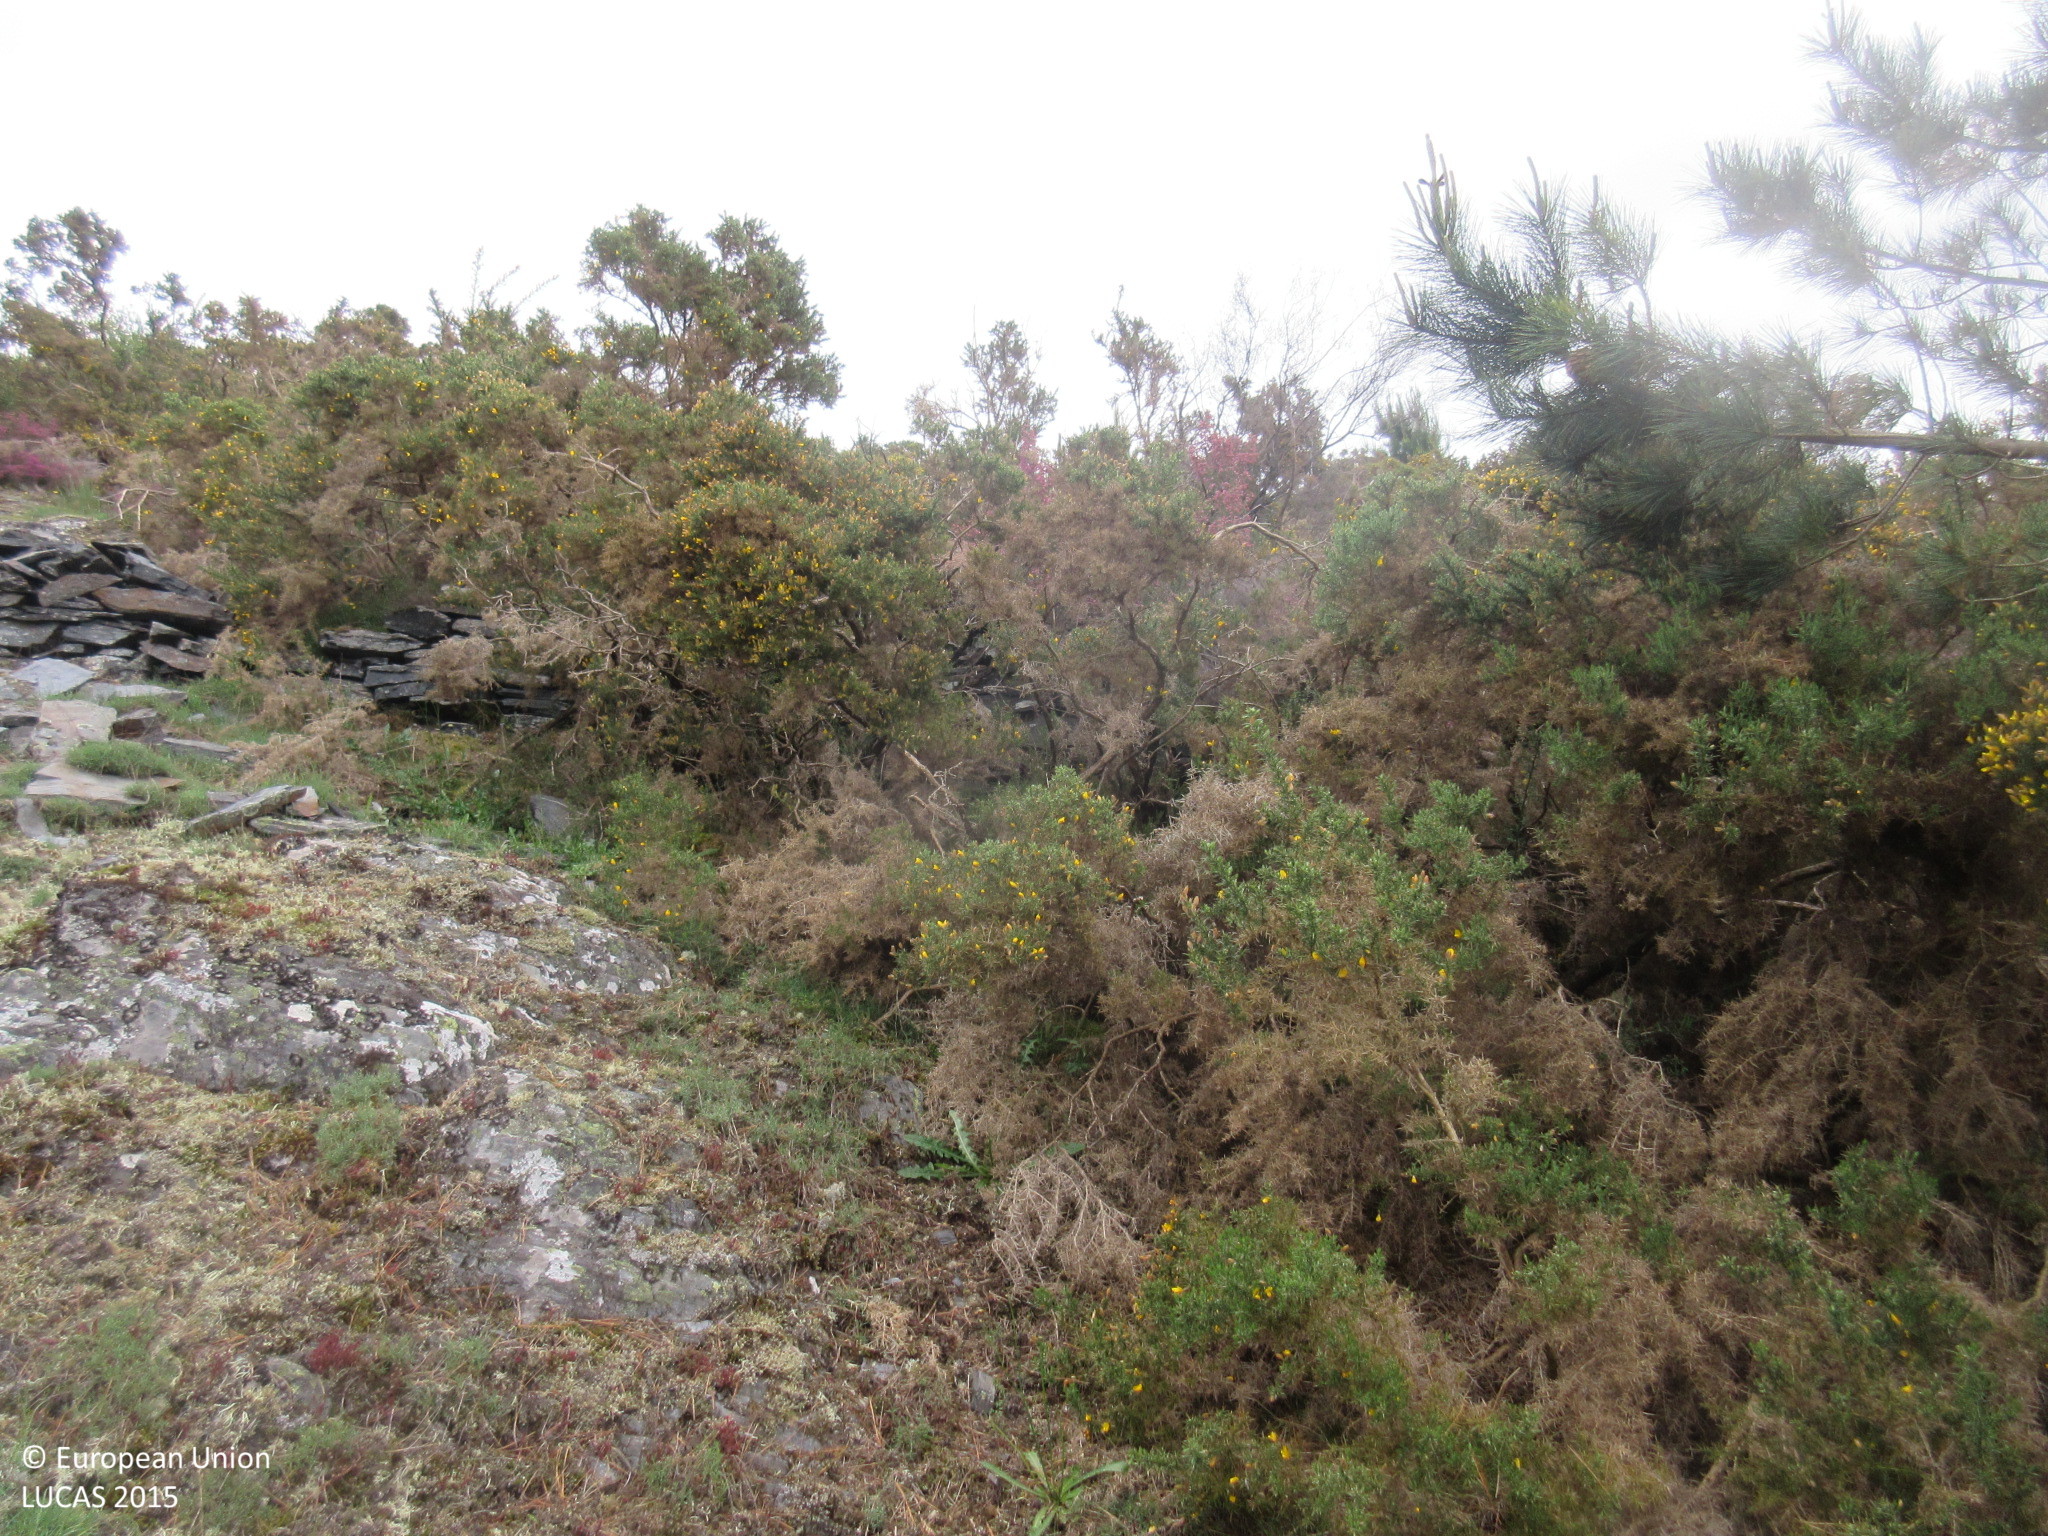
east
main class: Woodland
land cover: Broadleaved woodland
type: acidophilous oak and oak-birch forest
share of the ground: > 75 %
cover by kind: broadleaved forest trees 100 %
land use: Semi-natural and natural areas not in use
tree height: > 5 m
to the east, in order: Broadleaved woodland; Shrubland with sparse tree cover; Pine dominated coniferous woodland; Dry stone walls; Broadleaved woodland
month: April
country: ES
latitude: 43.2562
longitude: -6.9519
